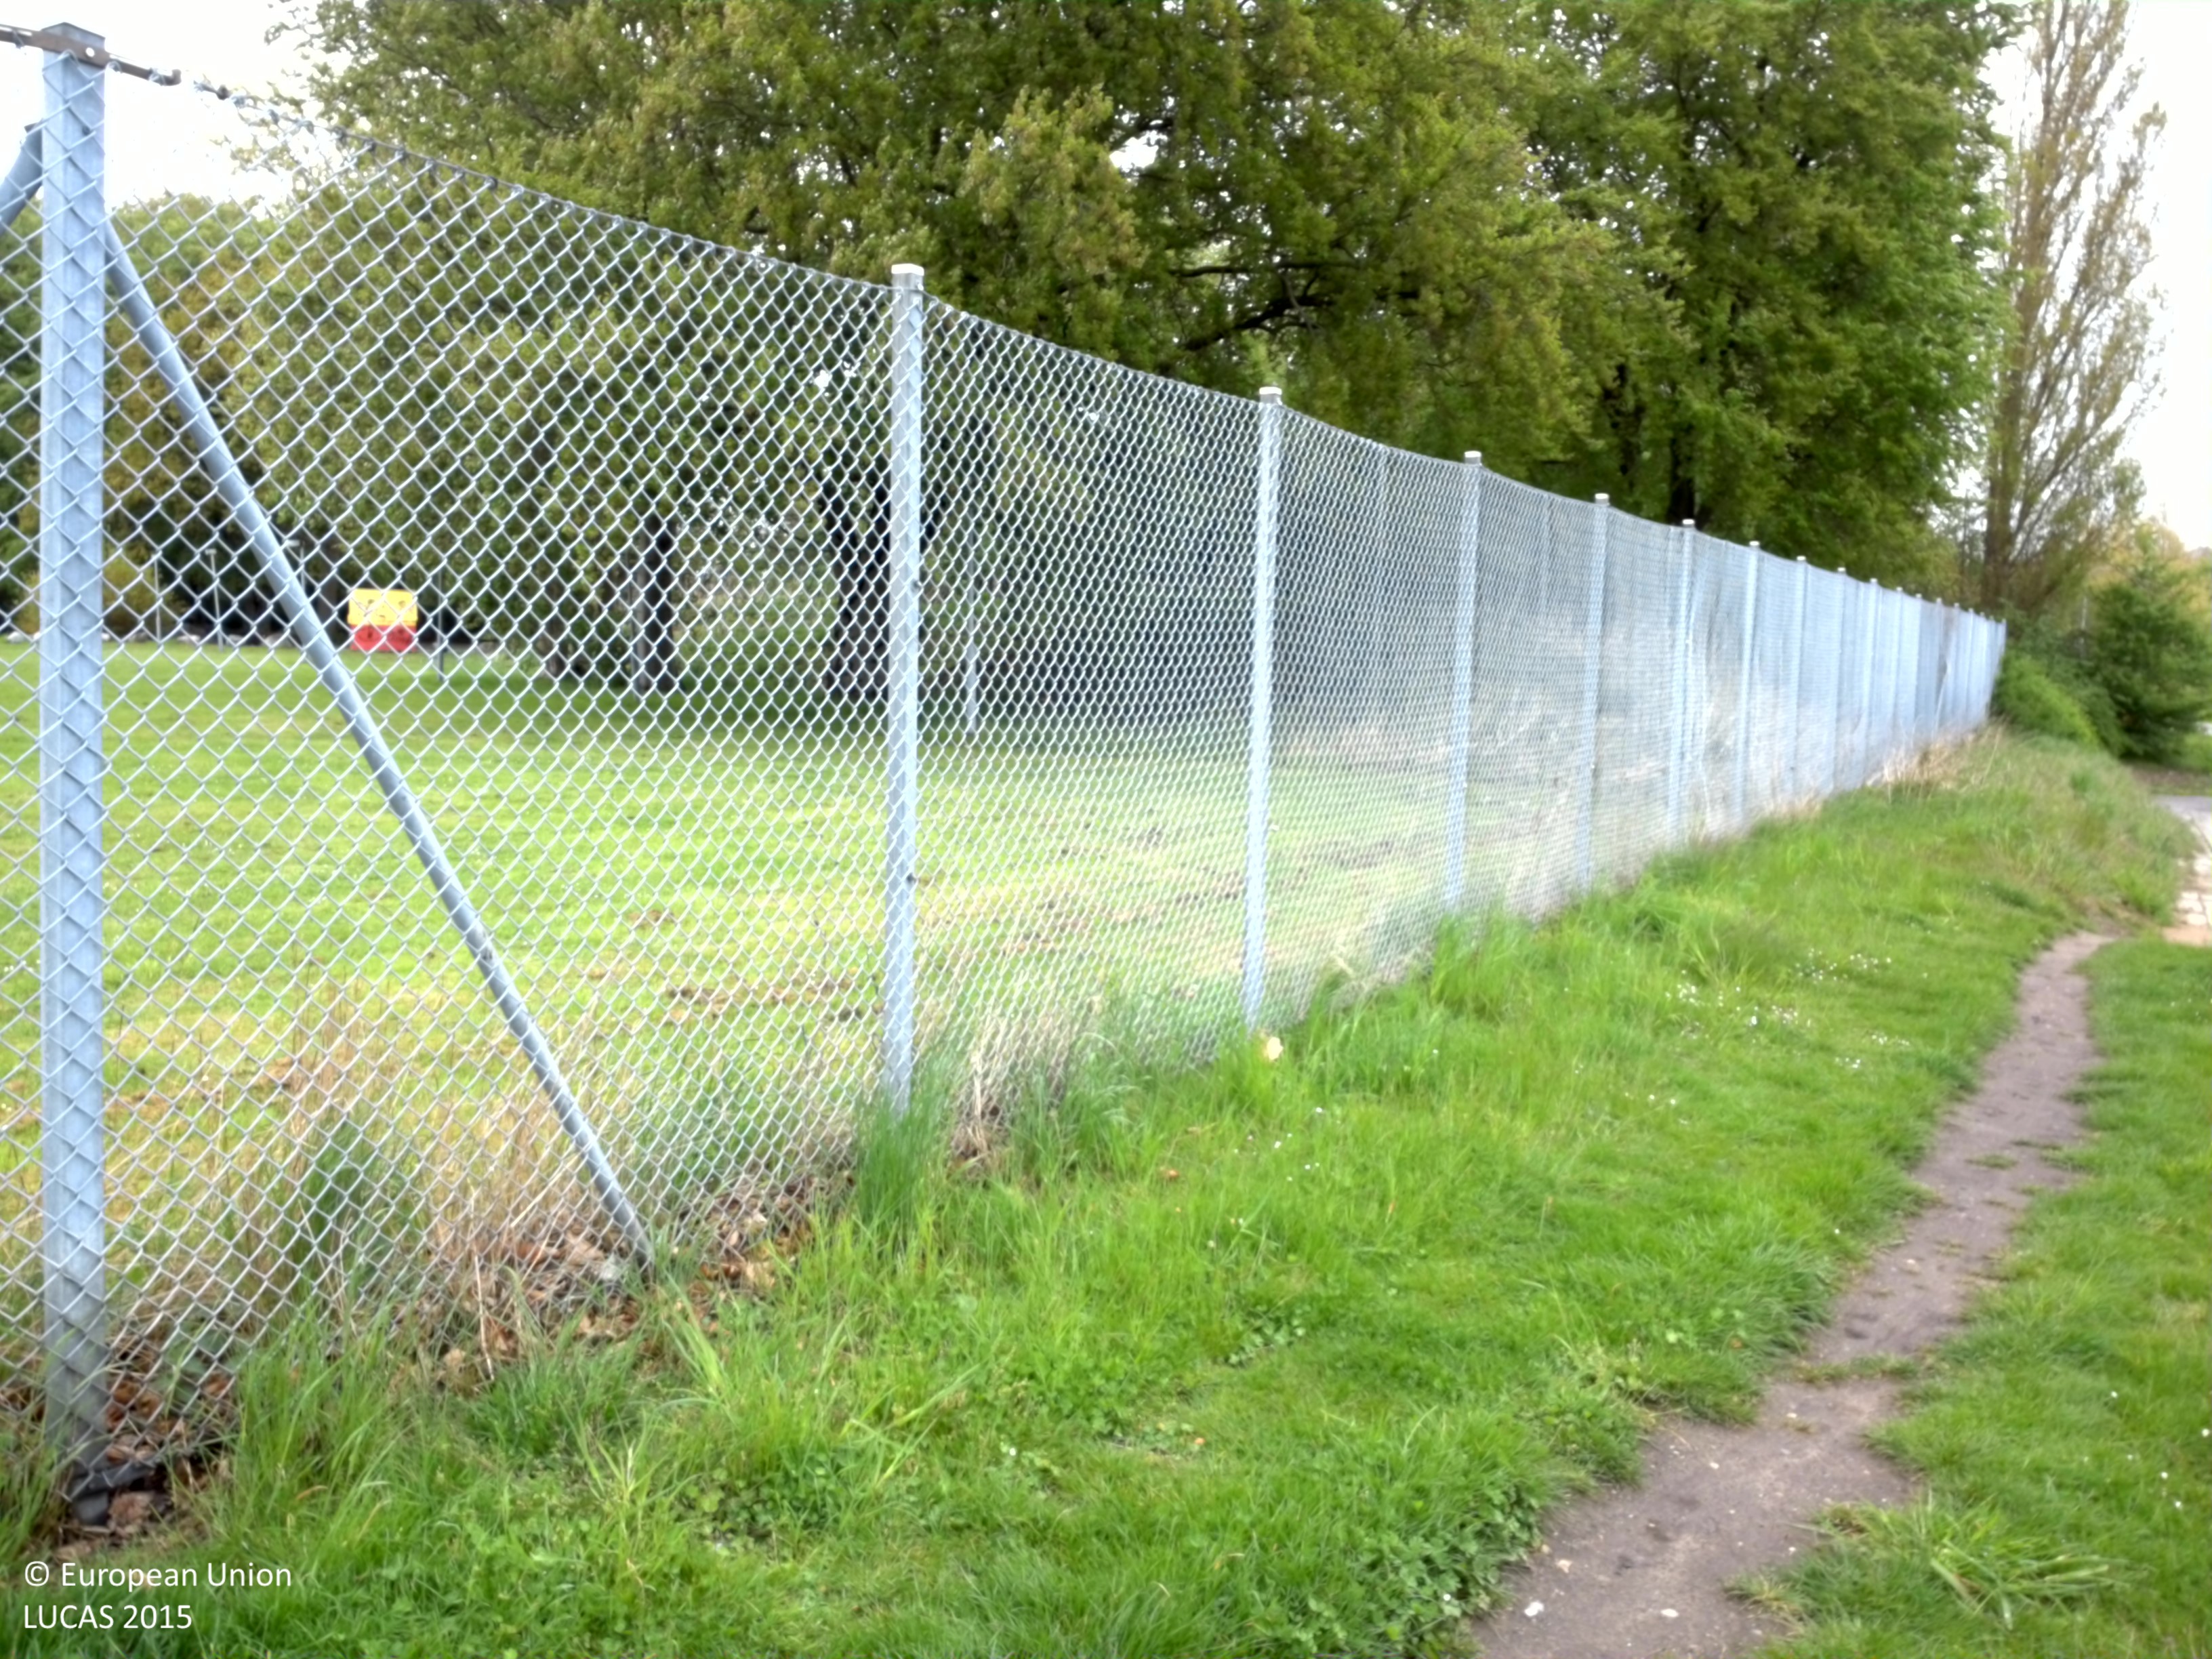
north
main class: Grassland
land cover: Grassland without tree/shrub cover
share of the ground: > 75 %
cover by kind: herbaceous plants 100 %
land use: Road transport
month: May
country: SE
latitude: 55.6116
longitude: 13.0620
